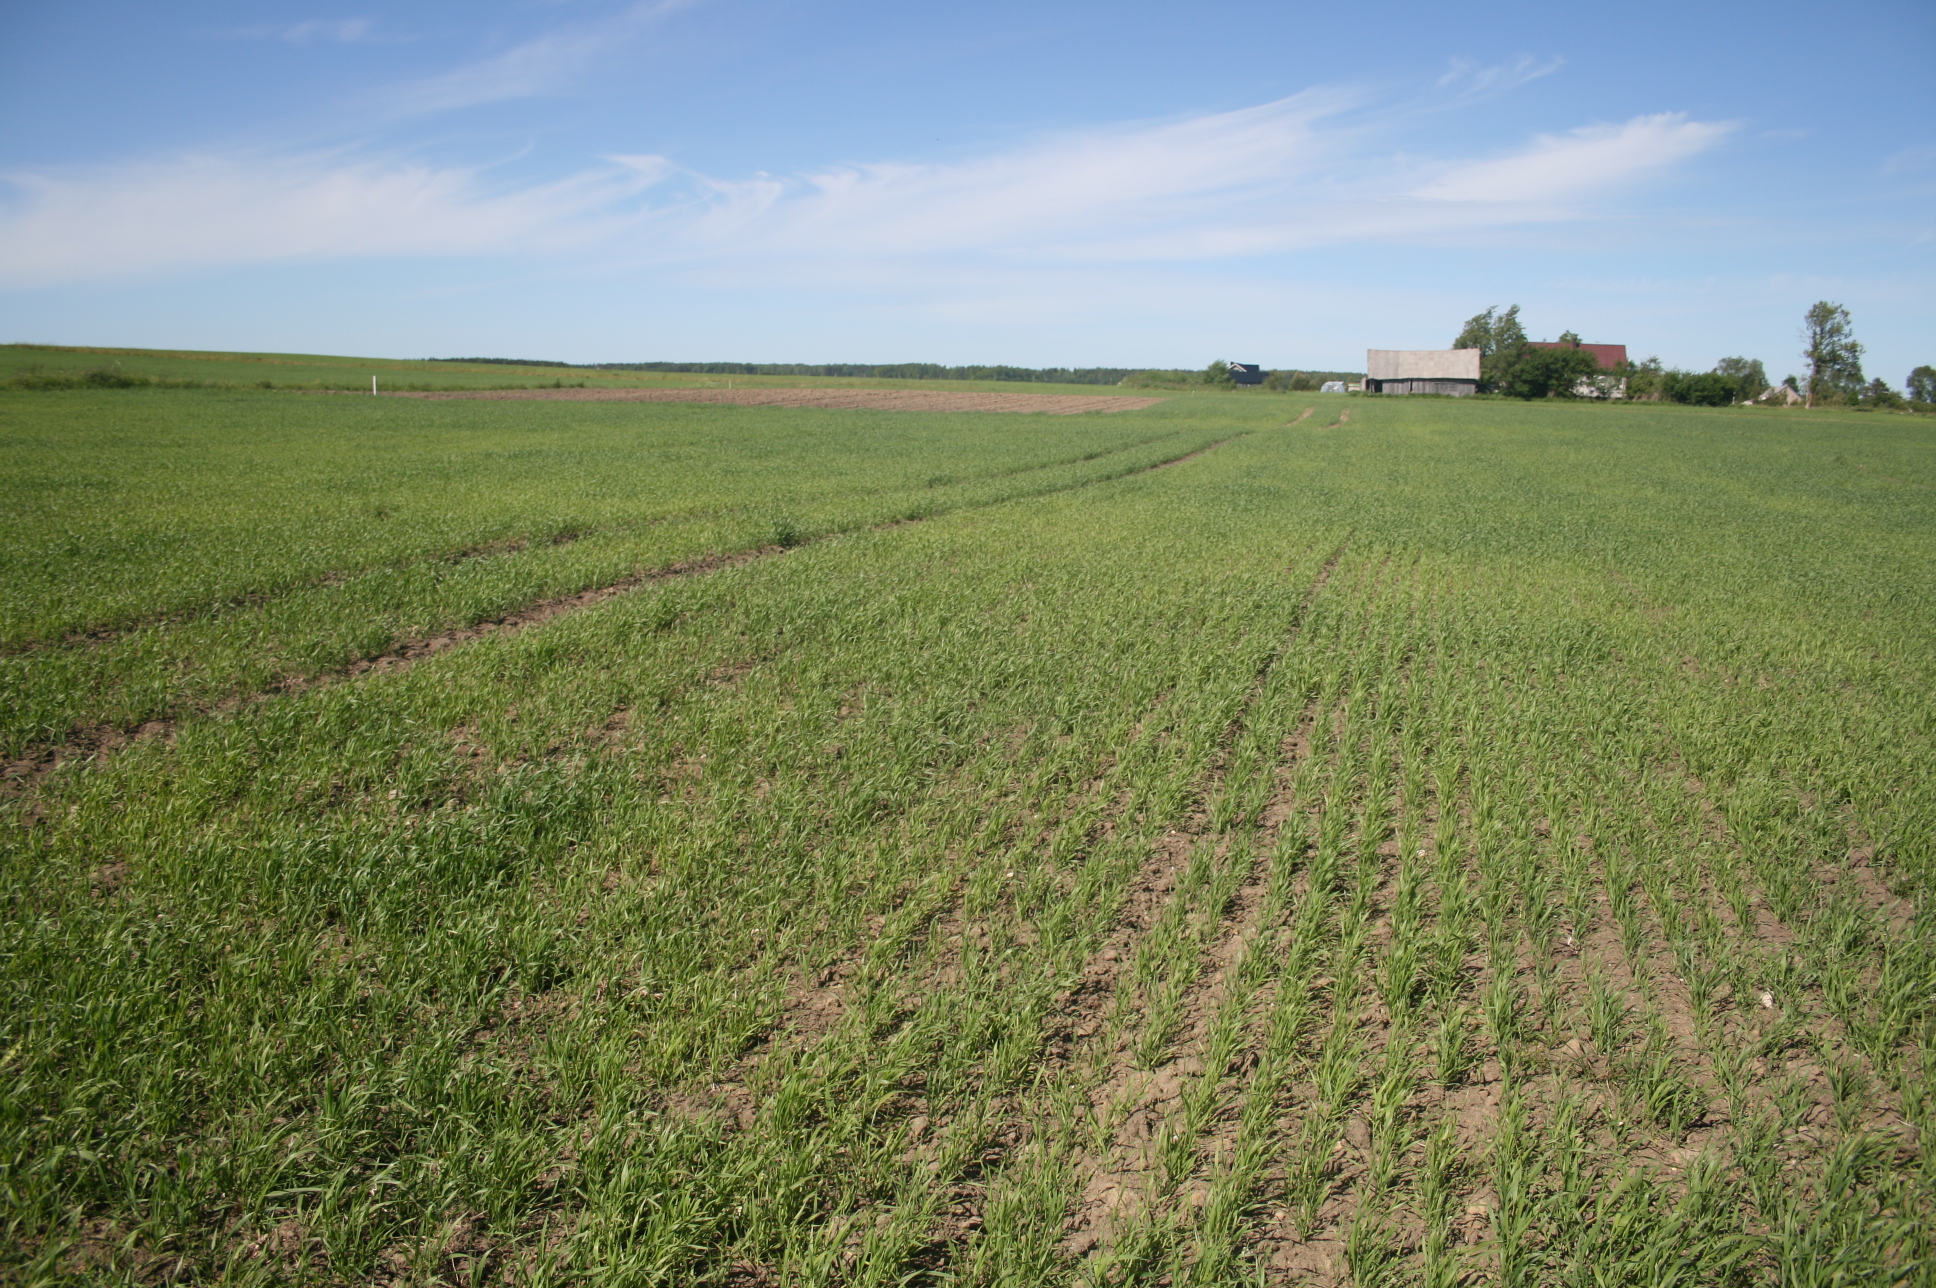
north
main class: Cropland
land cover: Common wheat
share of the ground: > 75 %
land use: Agriculture (excluding fallow land and kitchen gardens)
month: June
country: LT
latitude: 55.9451
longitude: 21.4603
